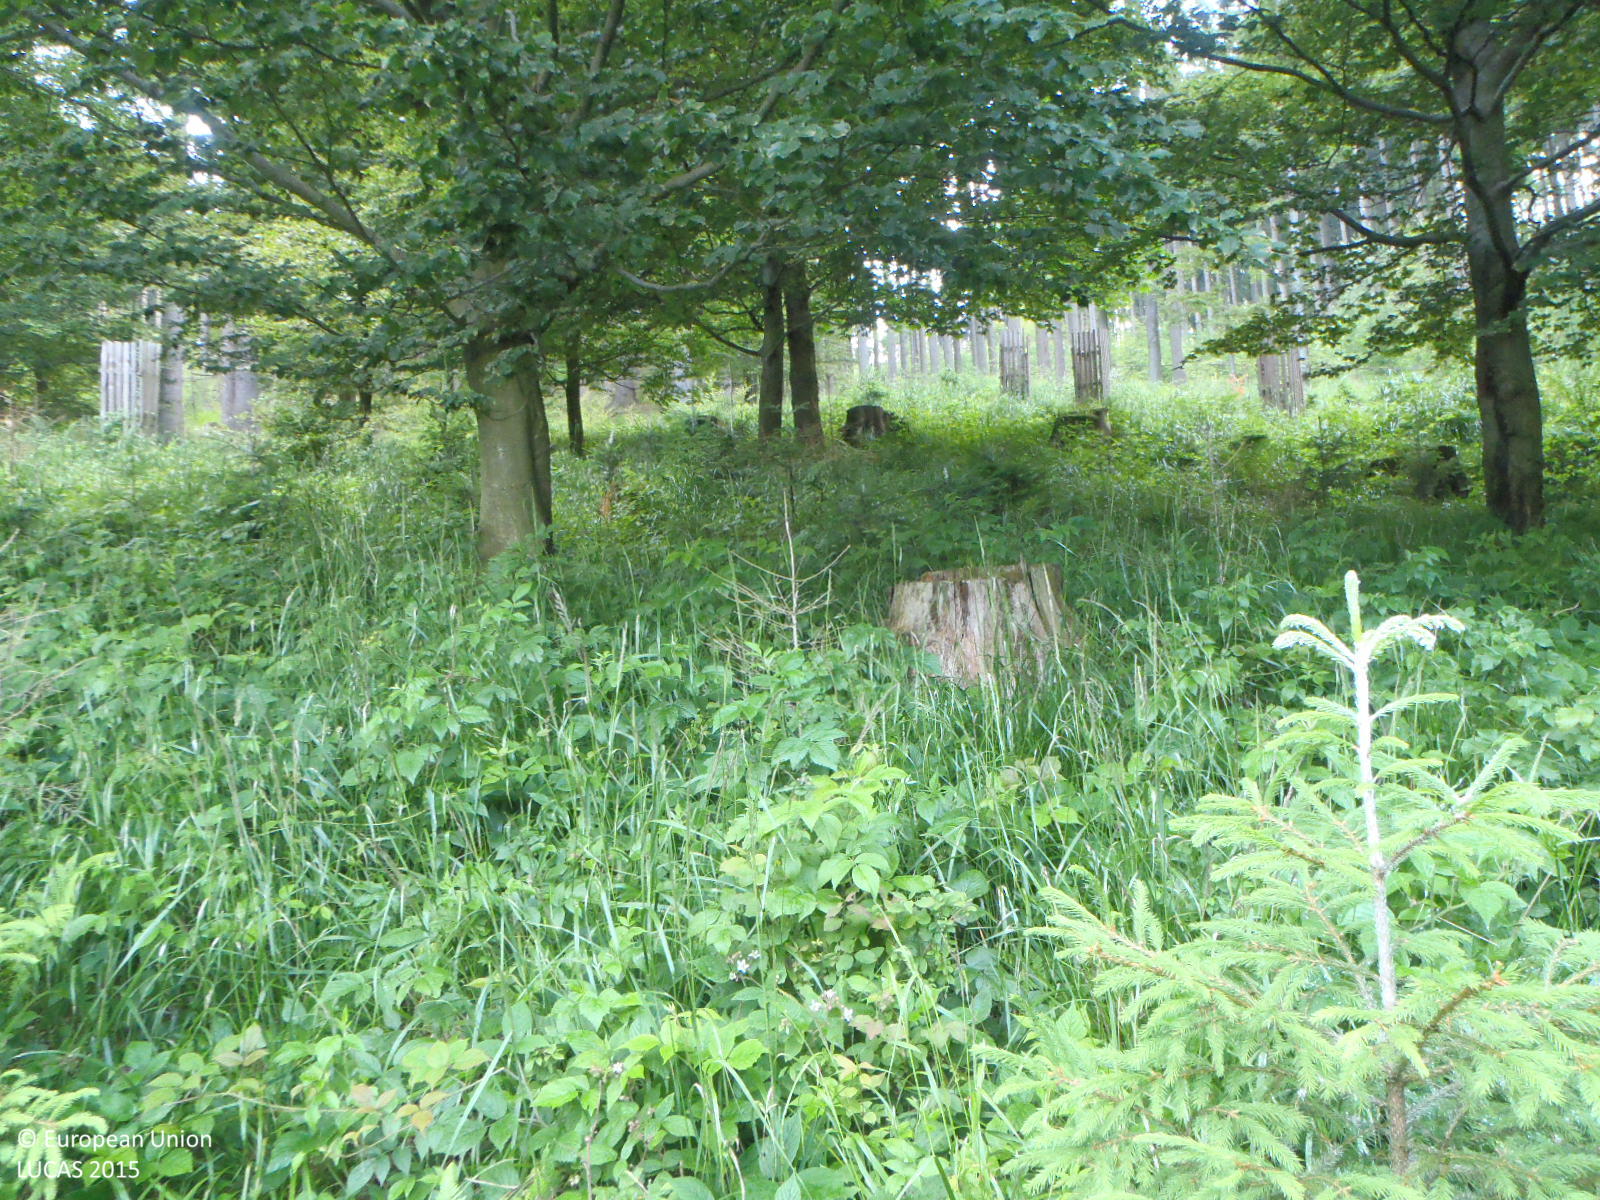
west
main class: Woodland
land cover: Broadleaved woodland
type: beech forest
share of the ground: > 75 %
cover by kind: broadleaved forest trees 75 %, shrubs 10 %, herbaceous plants 10 %, coniferous forest trees 5 %
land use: Forestry
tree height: > 5 m
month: June
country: CZ
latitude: 50.0519
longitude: 17.1192
